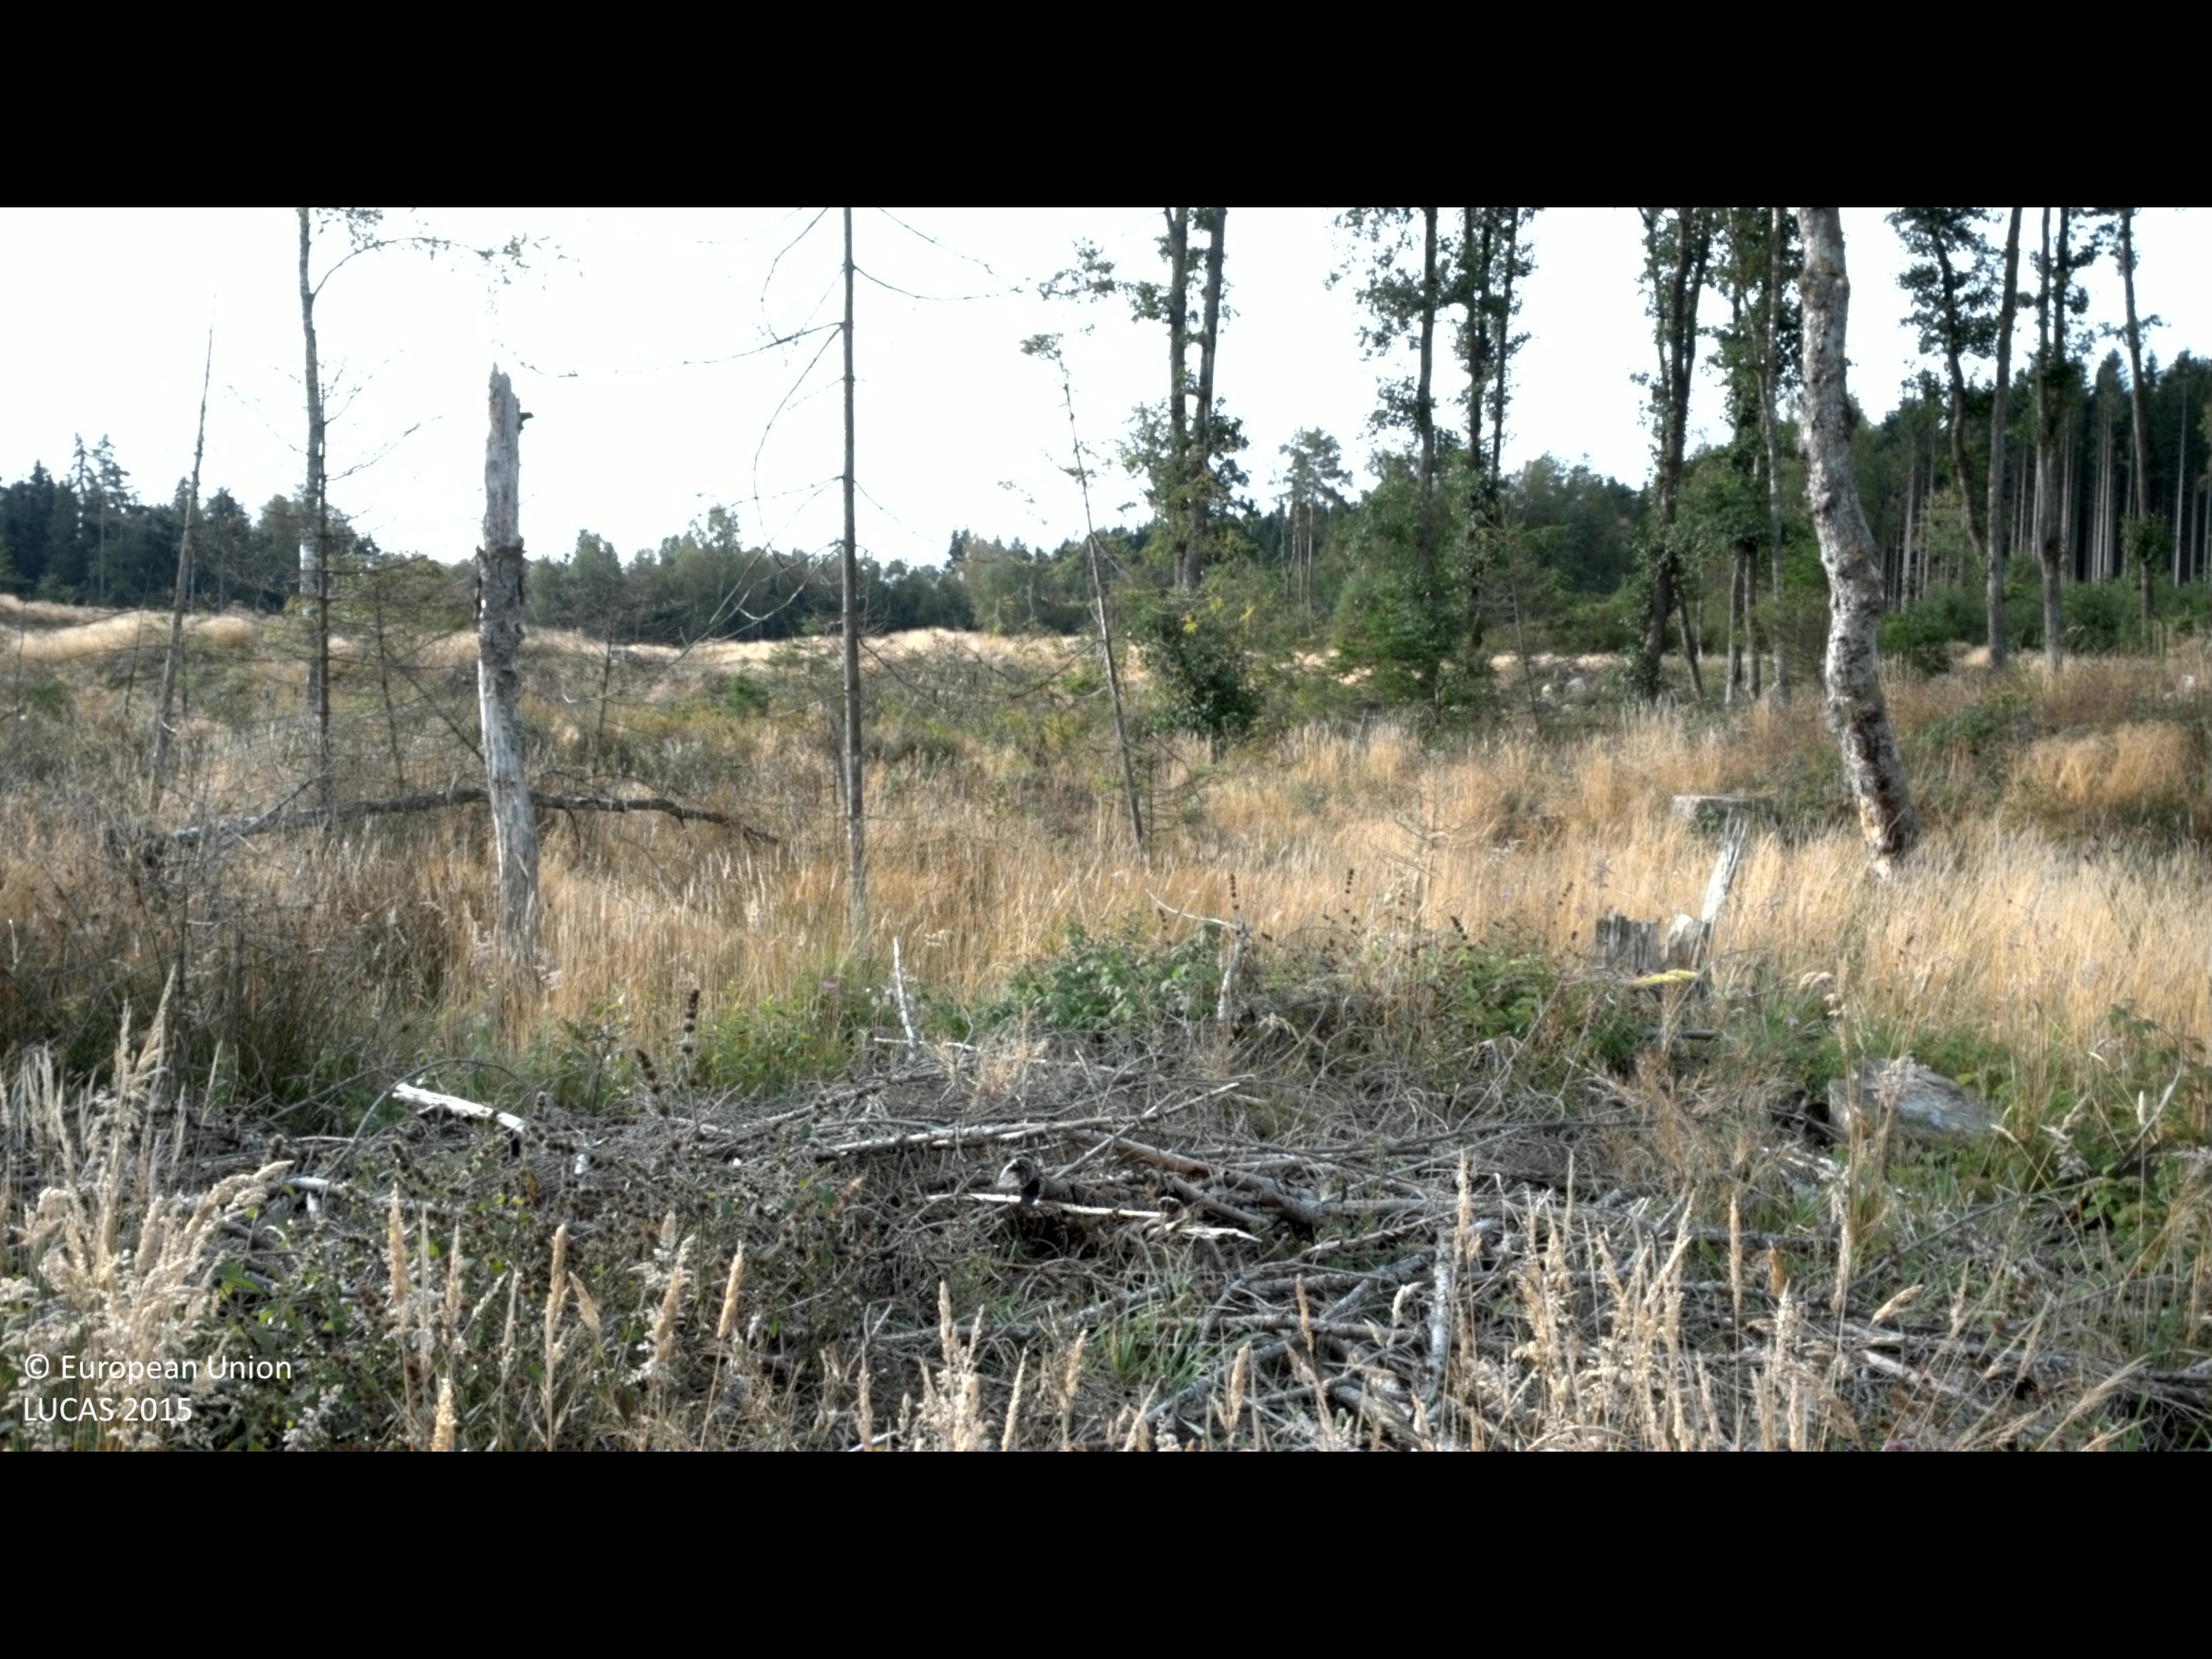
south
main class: Grassland
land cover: Grassland with sparse tree/shrub cover
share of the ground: > 75 %
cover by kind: herbaceous plants 90 %, broadleaved forest trees 5 %, shrubs 5 %
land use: Forestry
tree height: > 5 m
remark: Clear cut
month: September
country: SE
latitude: 56.9486
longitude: 12.8079
